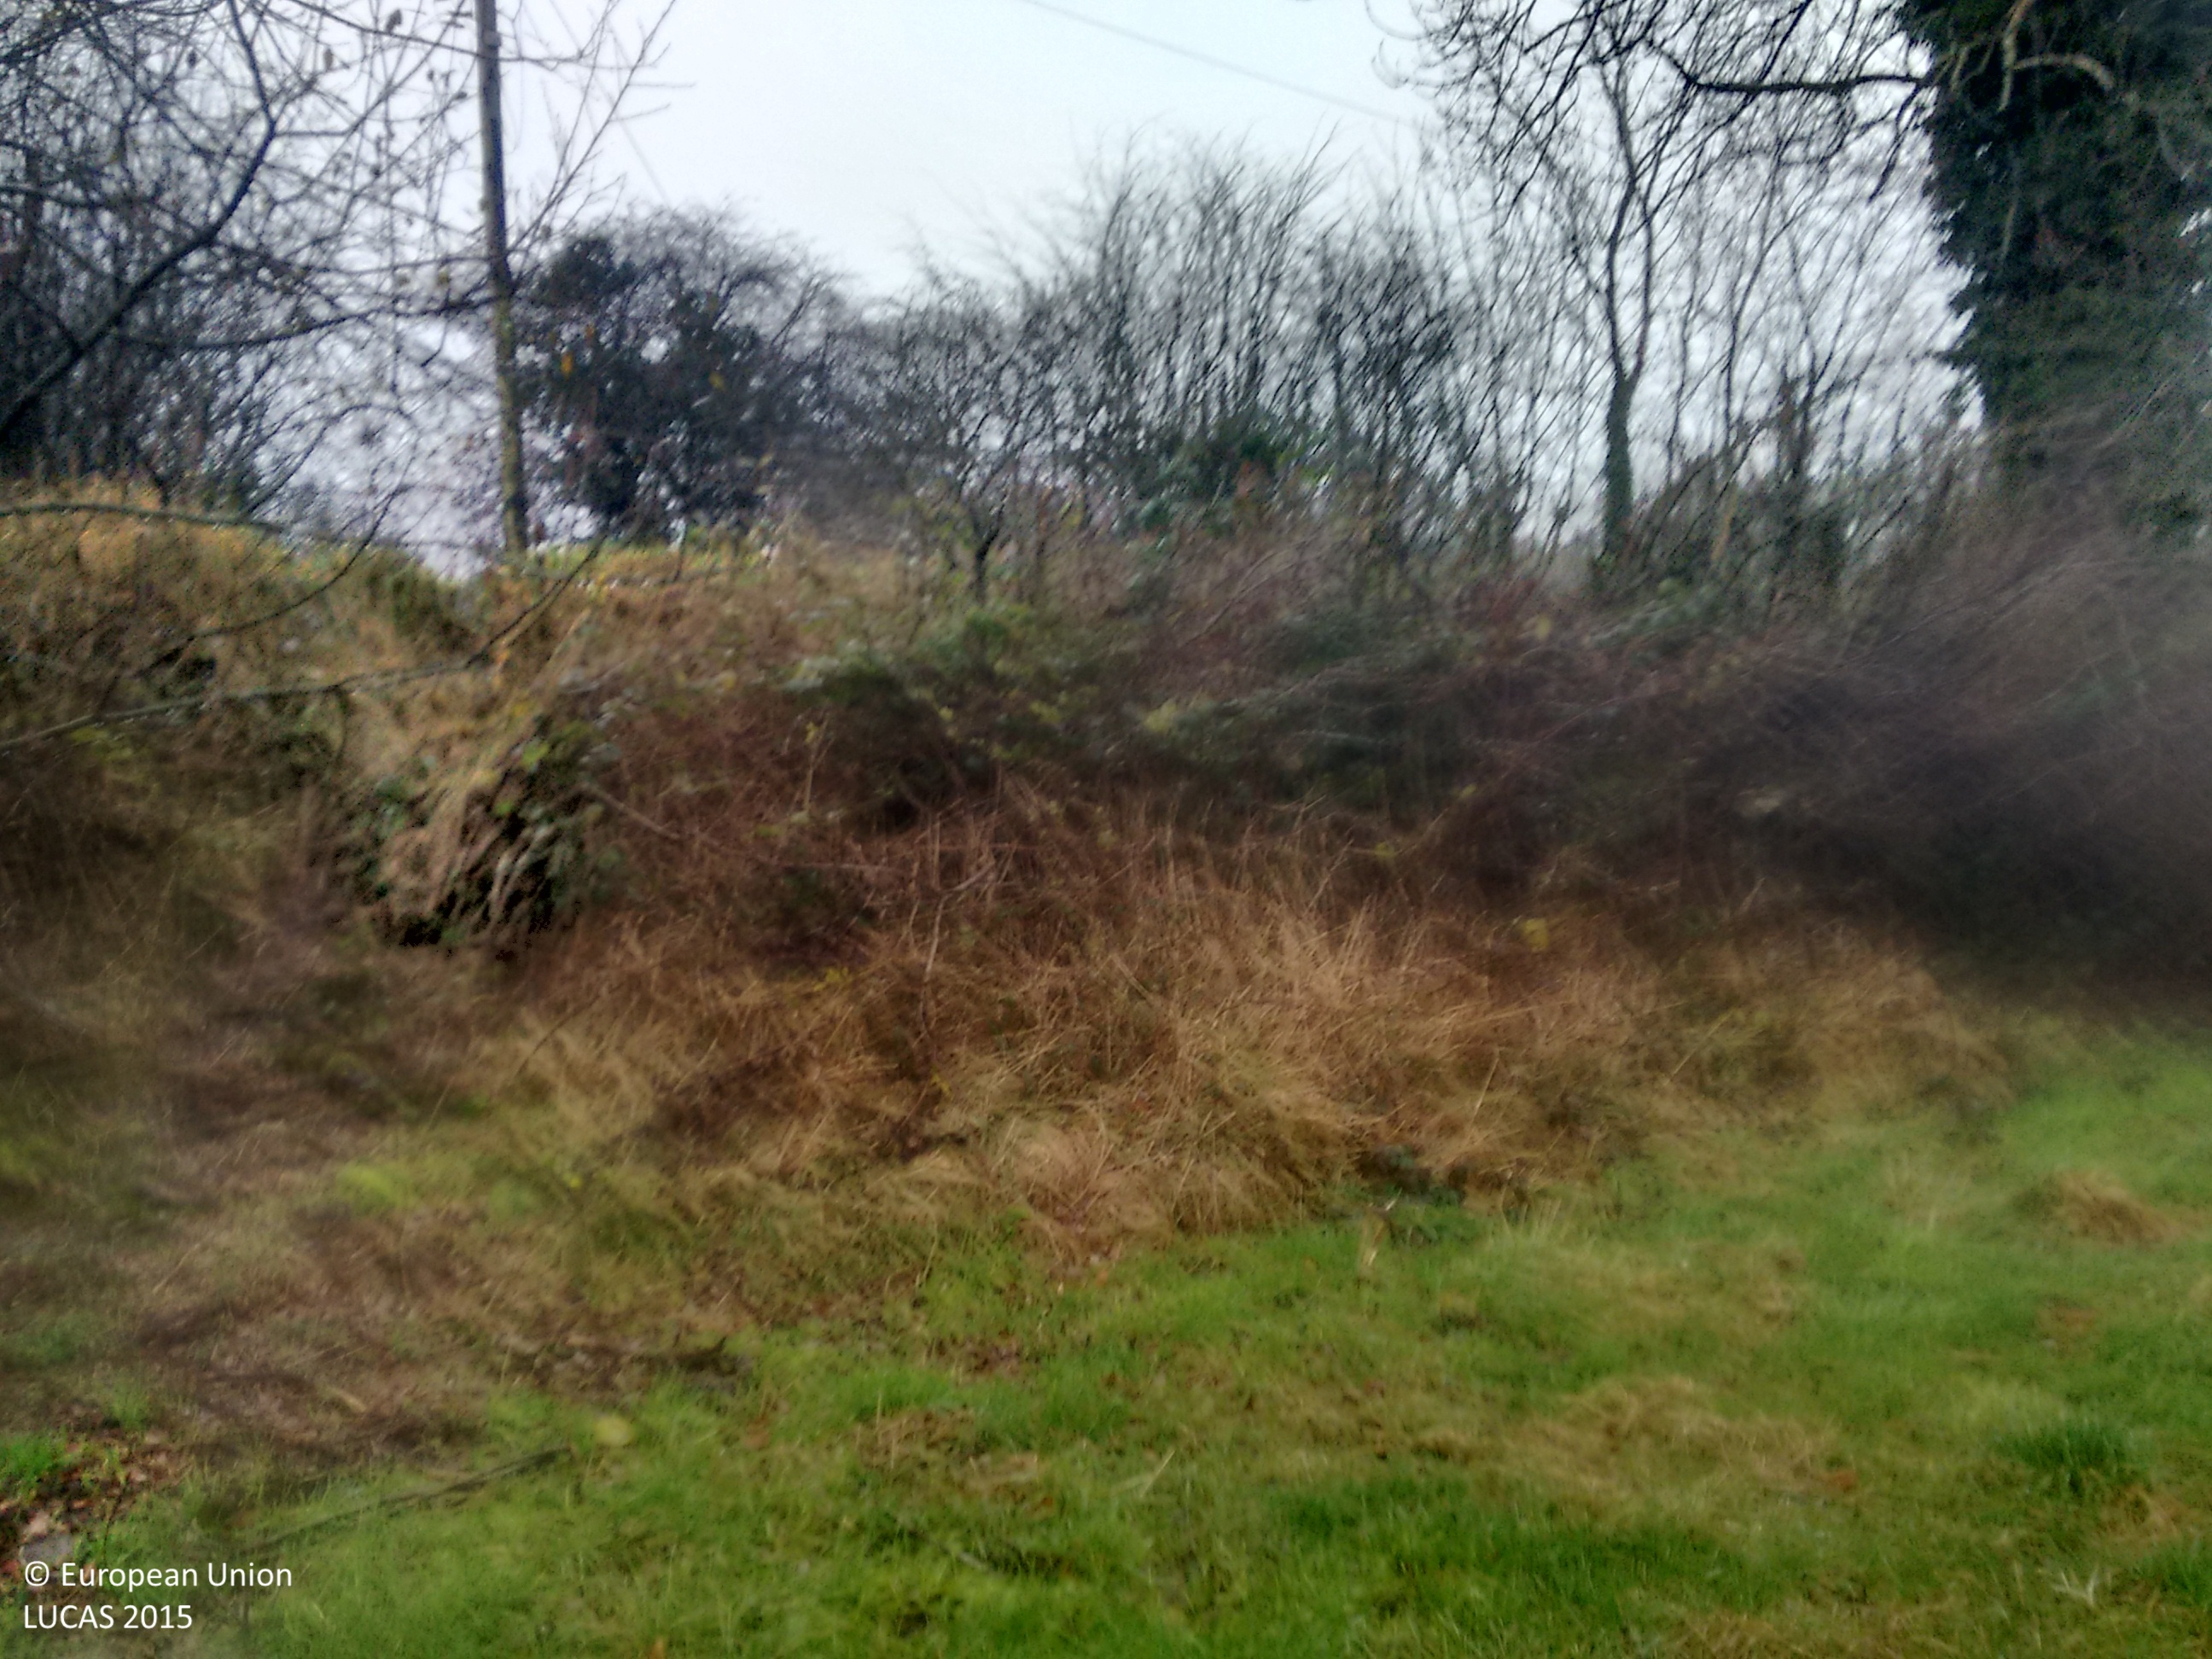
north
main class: Grassland
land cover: Grassland without tree/shrub cover
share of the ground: > 75 %
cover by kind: herbaceous plants 95 %, unconsolidated bare surface 5 %
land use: Agriculture (excluding fallow land and kitchen gardens)
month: December
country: IE
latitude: 54.1703
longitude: -7.2909
